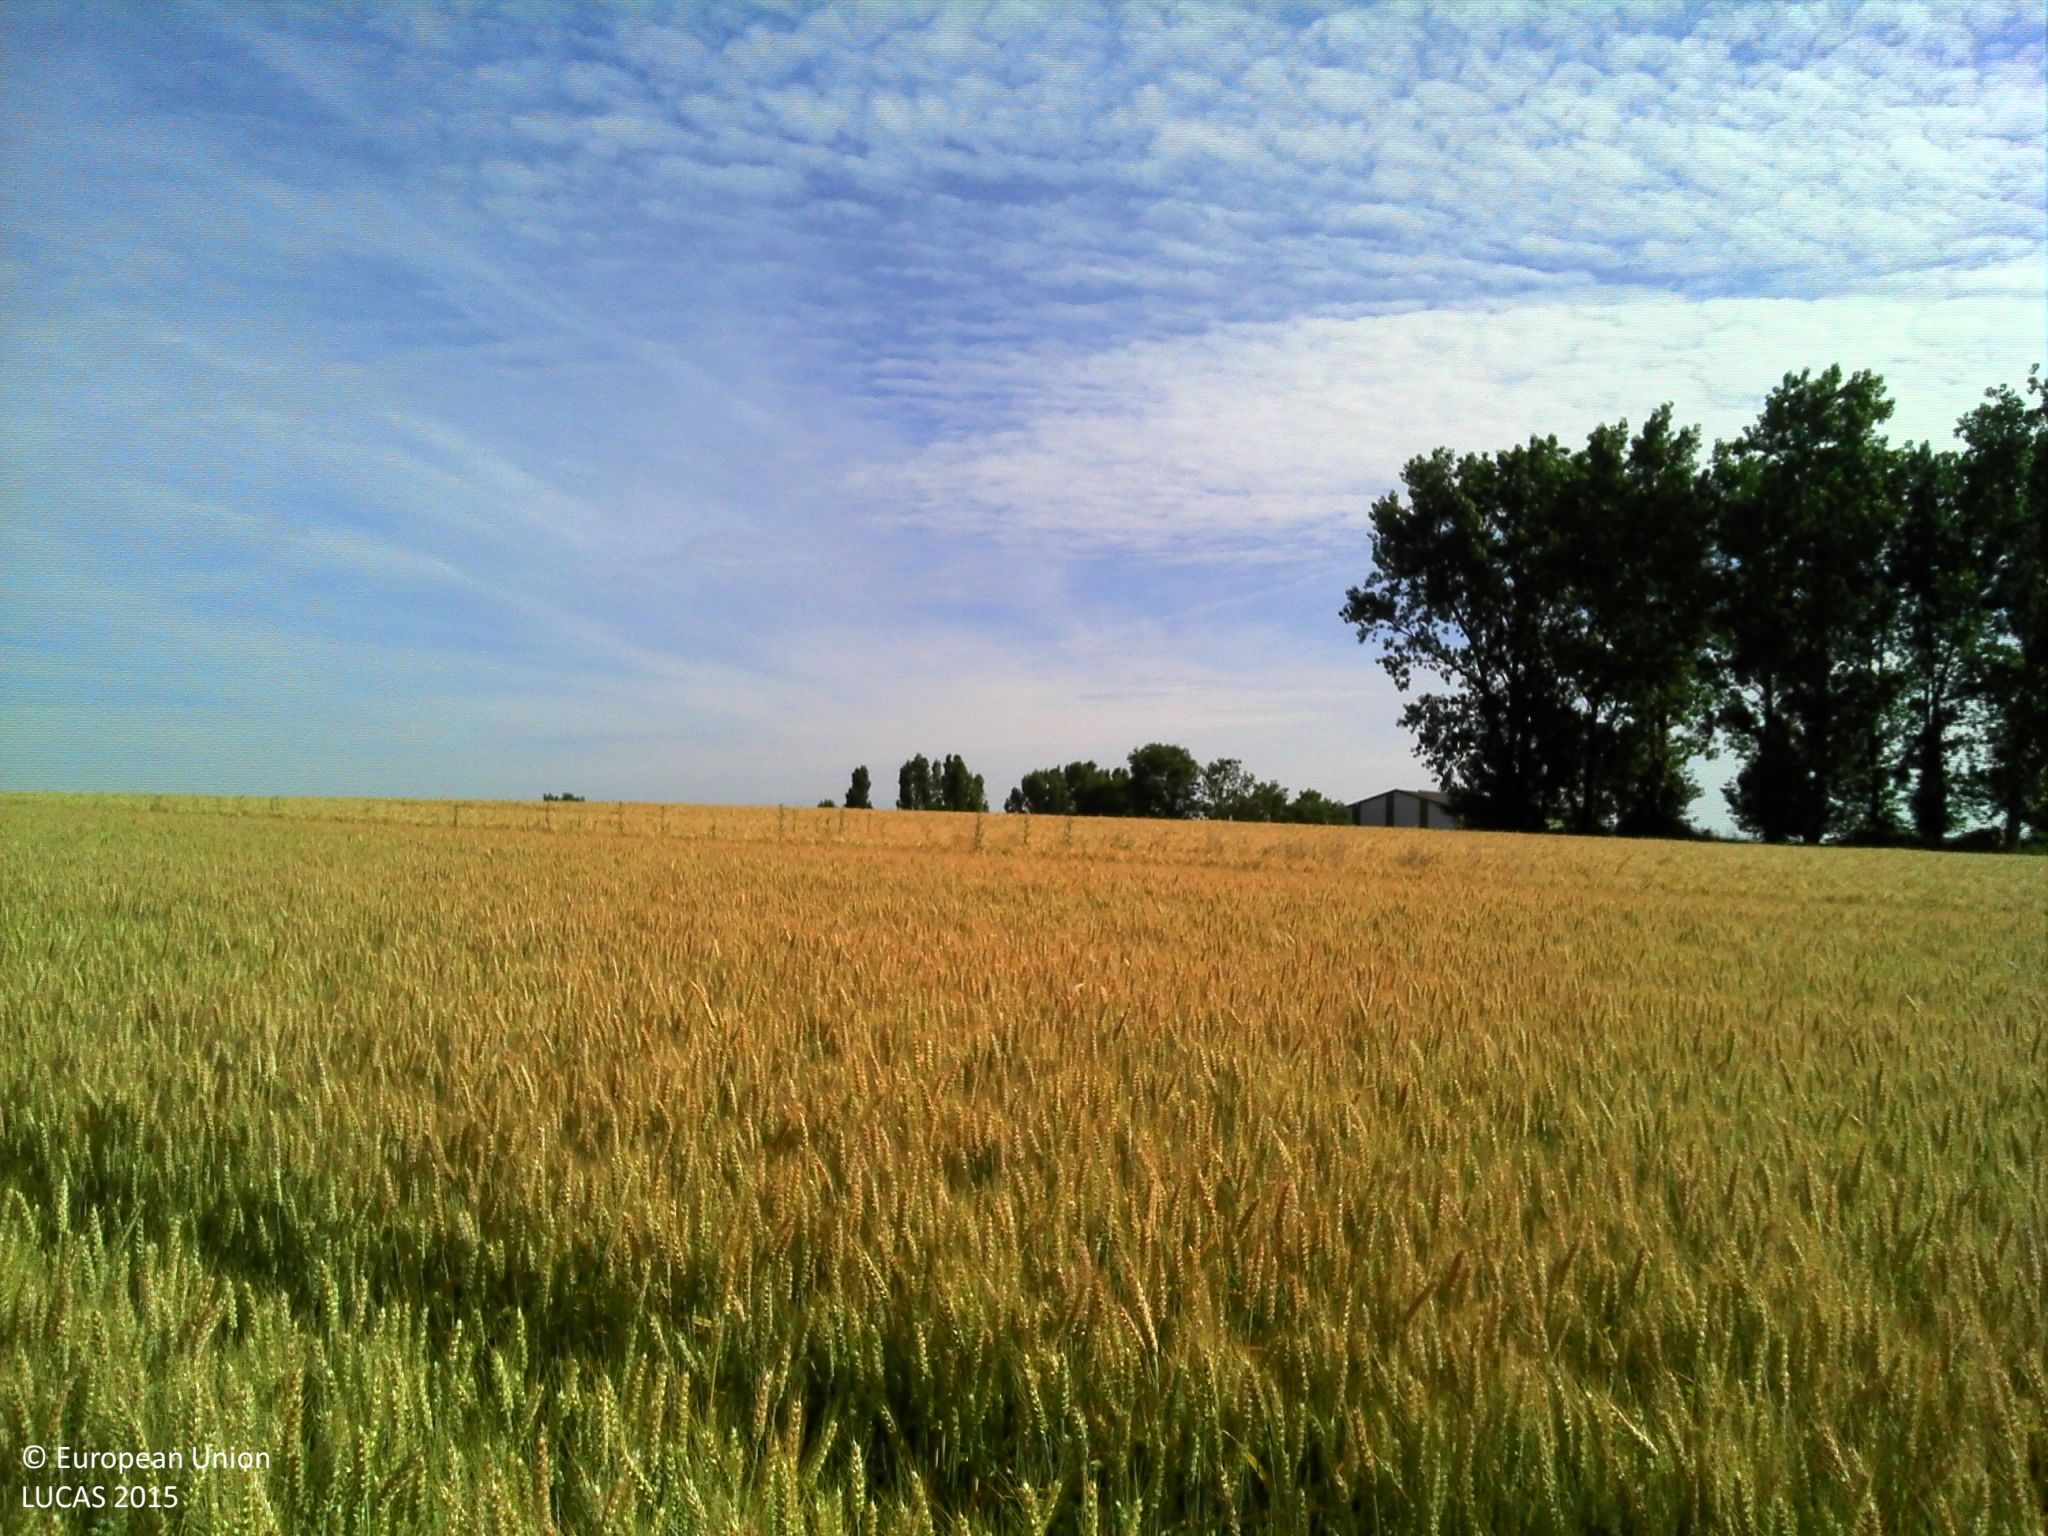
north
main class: Cropland
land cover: Triticale
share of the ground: > 75 %
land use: Agriculture (excluding fallow land and kitchen gardens)
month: June
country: FR
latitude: 48.2780
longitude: 0.2309
